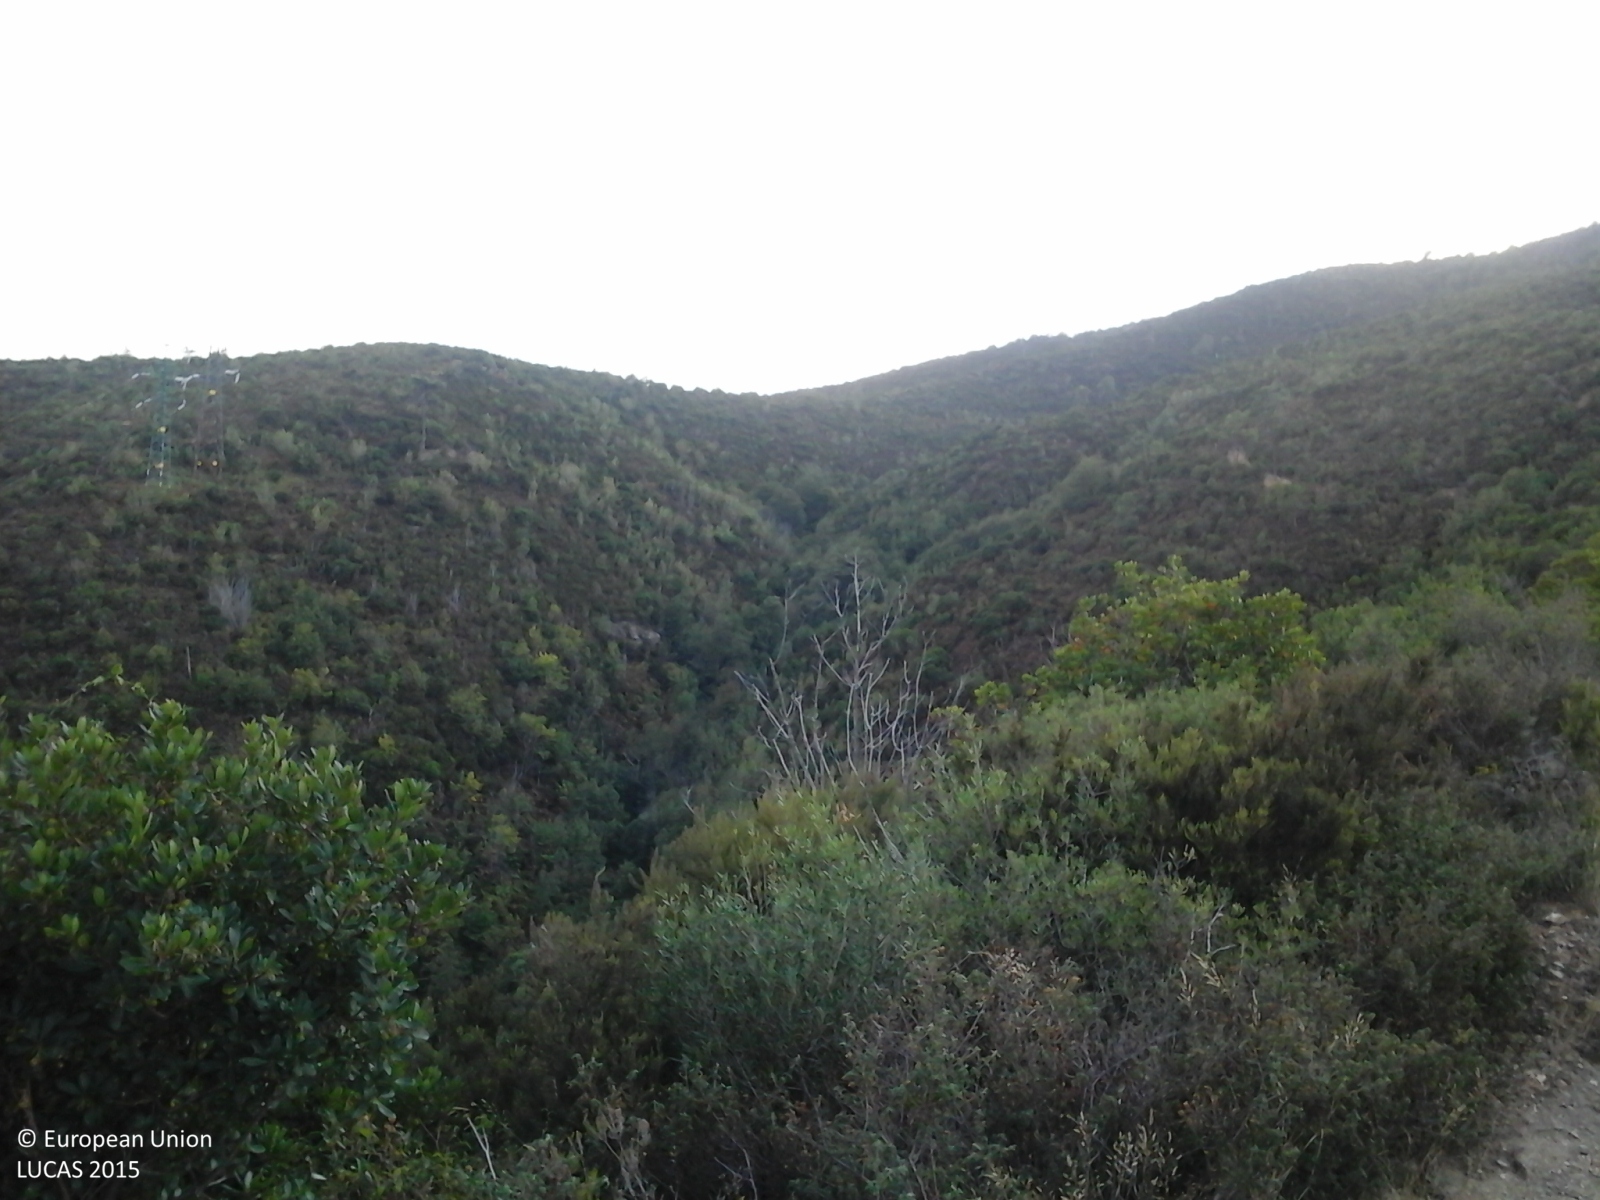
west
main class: Shrubland
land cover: Shrubland without tree cover
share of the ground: > 75 %
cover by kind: shrubs 80 %, herbaceous plants 10 %, consolidated bare surface 10 %
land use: Semi-natural and natural areas not in use
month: September
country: IT
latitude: 44.2843
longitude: 8.4122
